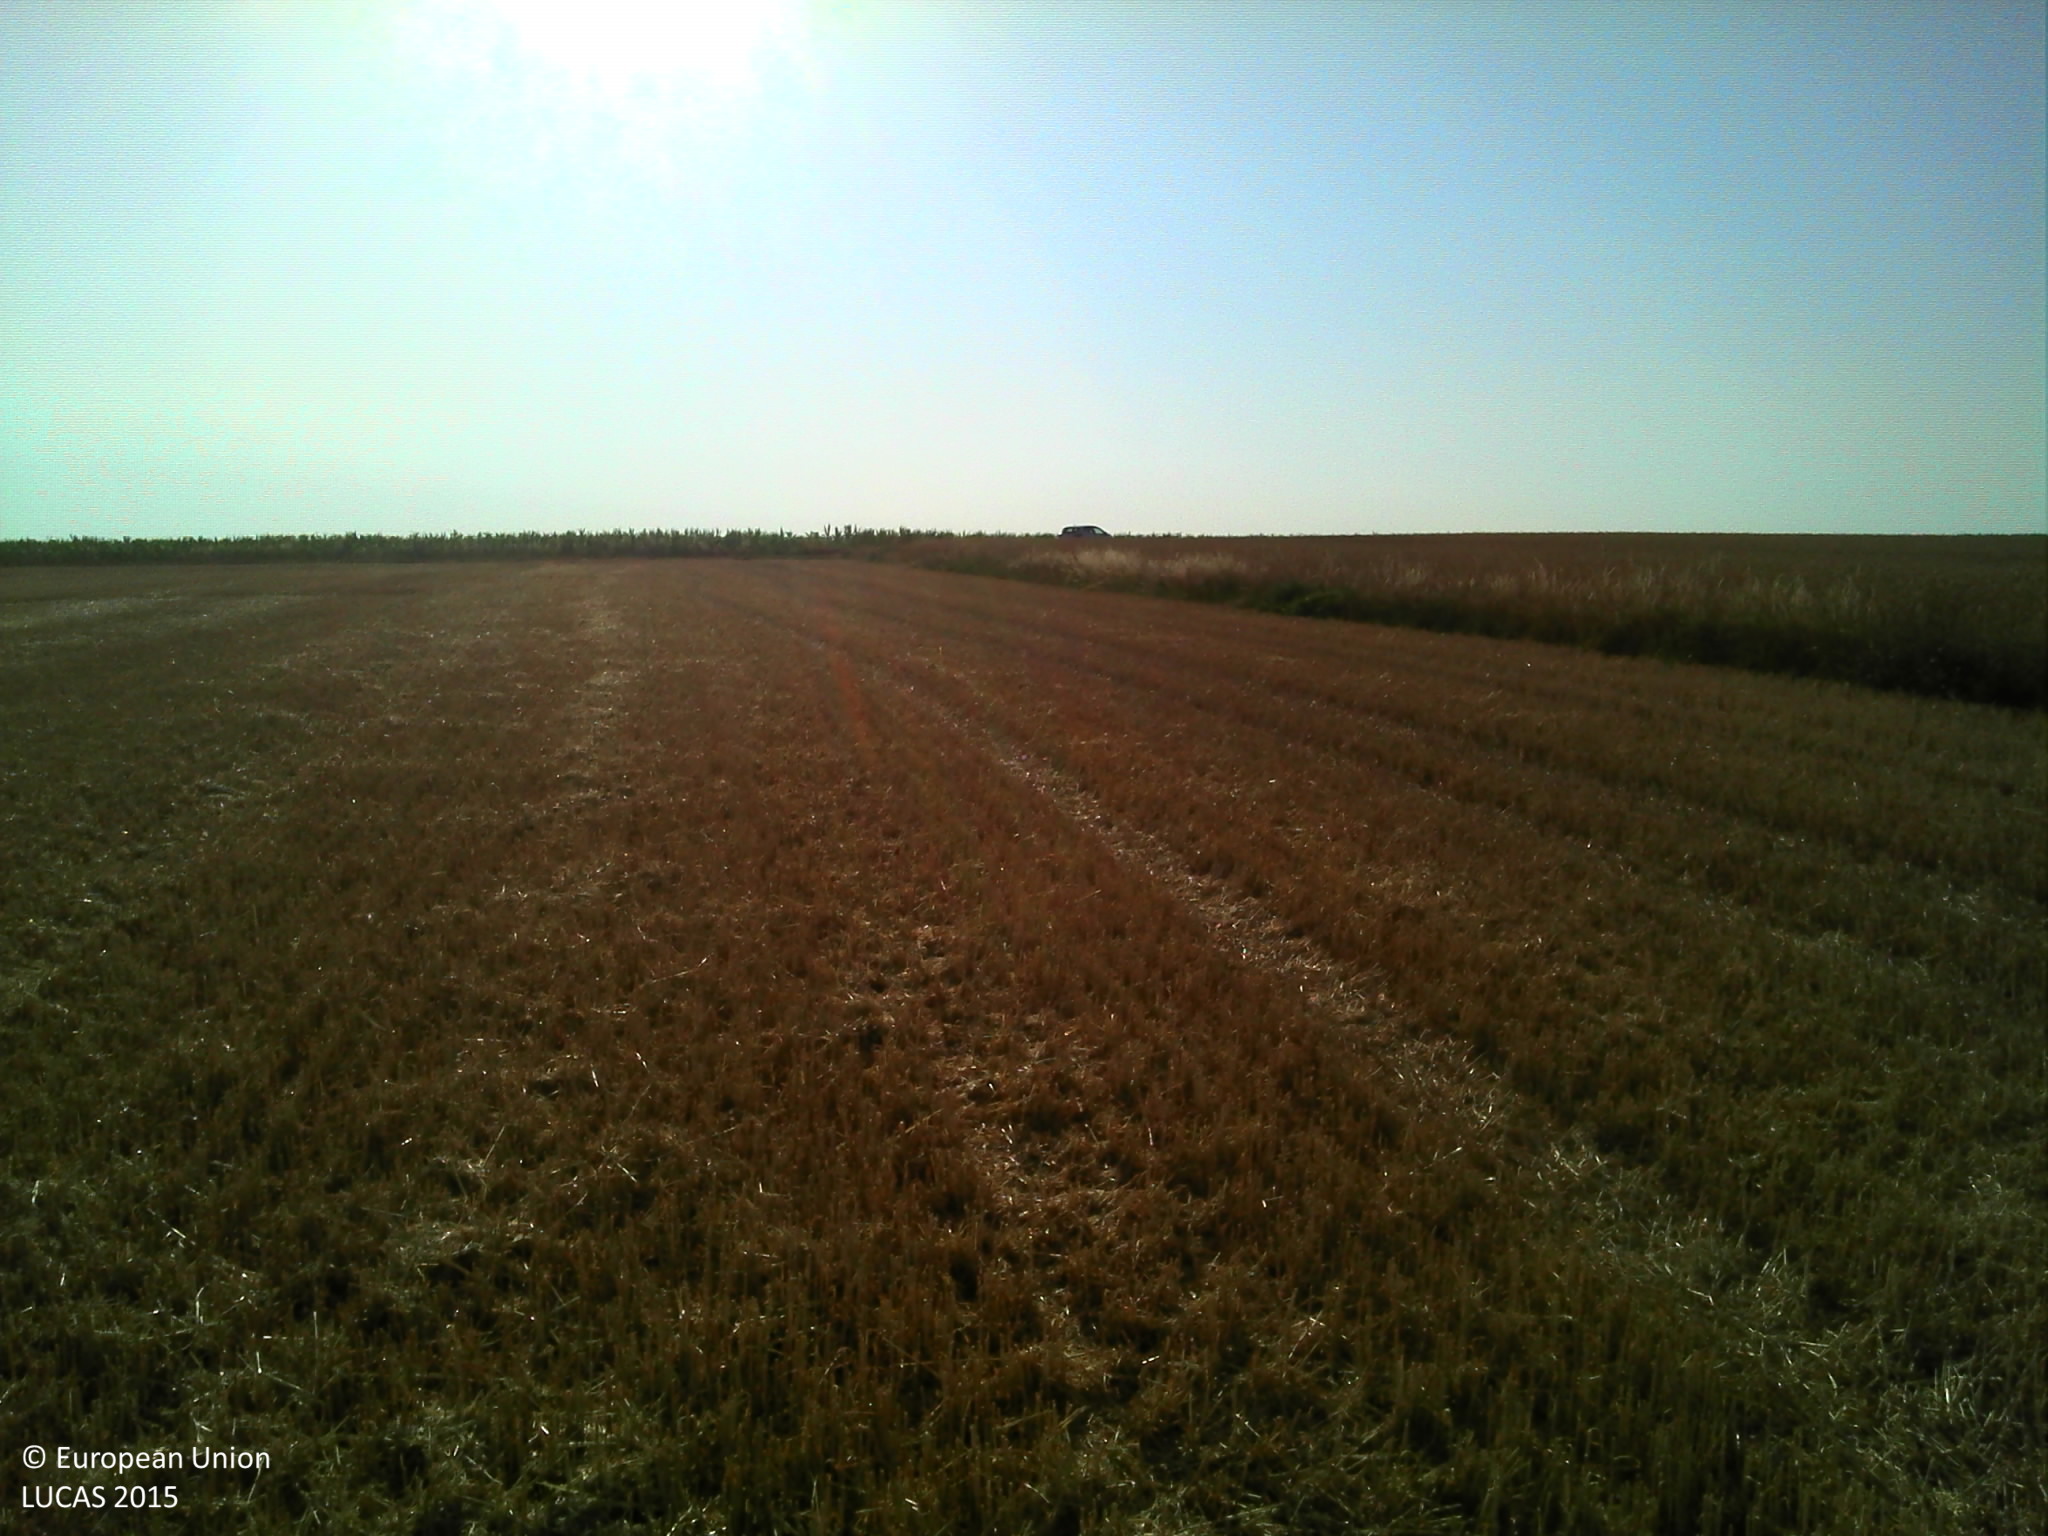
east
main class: Cropland
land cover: Common wheat
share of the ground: > 75 %
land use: Agriculture (excluding fallow land and kitchen gardens)
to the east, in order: Common wheat; Grass margins; Tracks; Grass margins; Maize
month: July
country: FR
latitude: 47.6859
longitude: 3.4544
